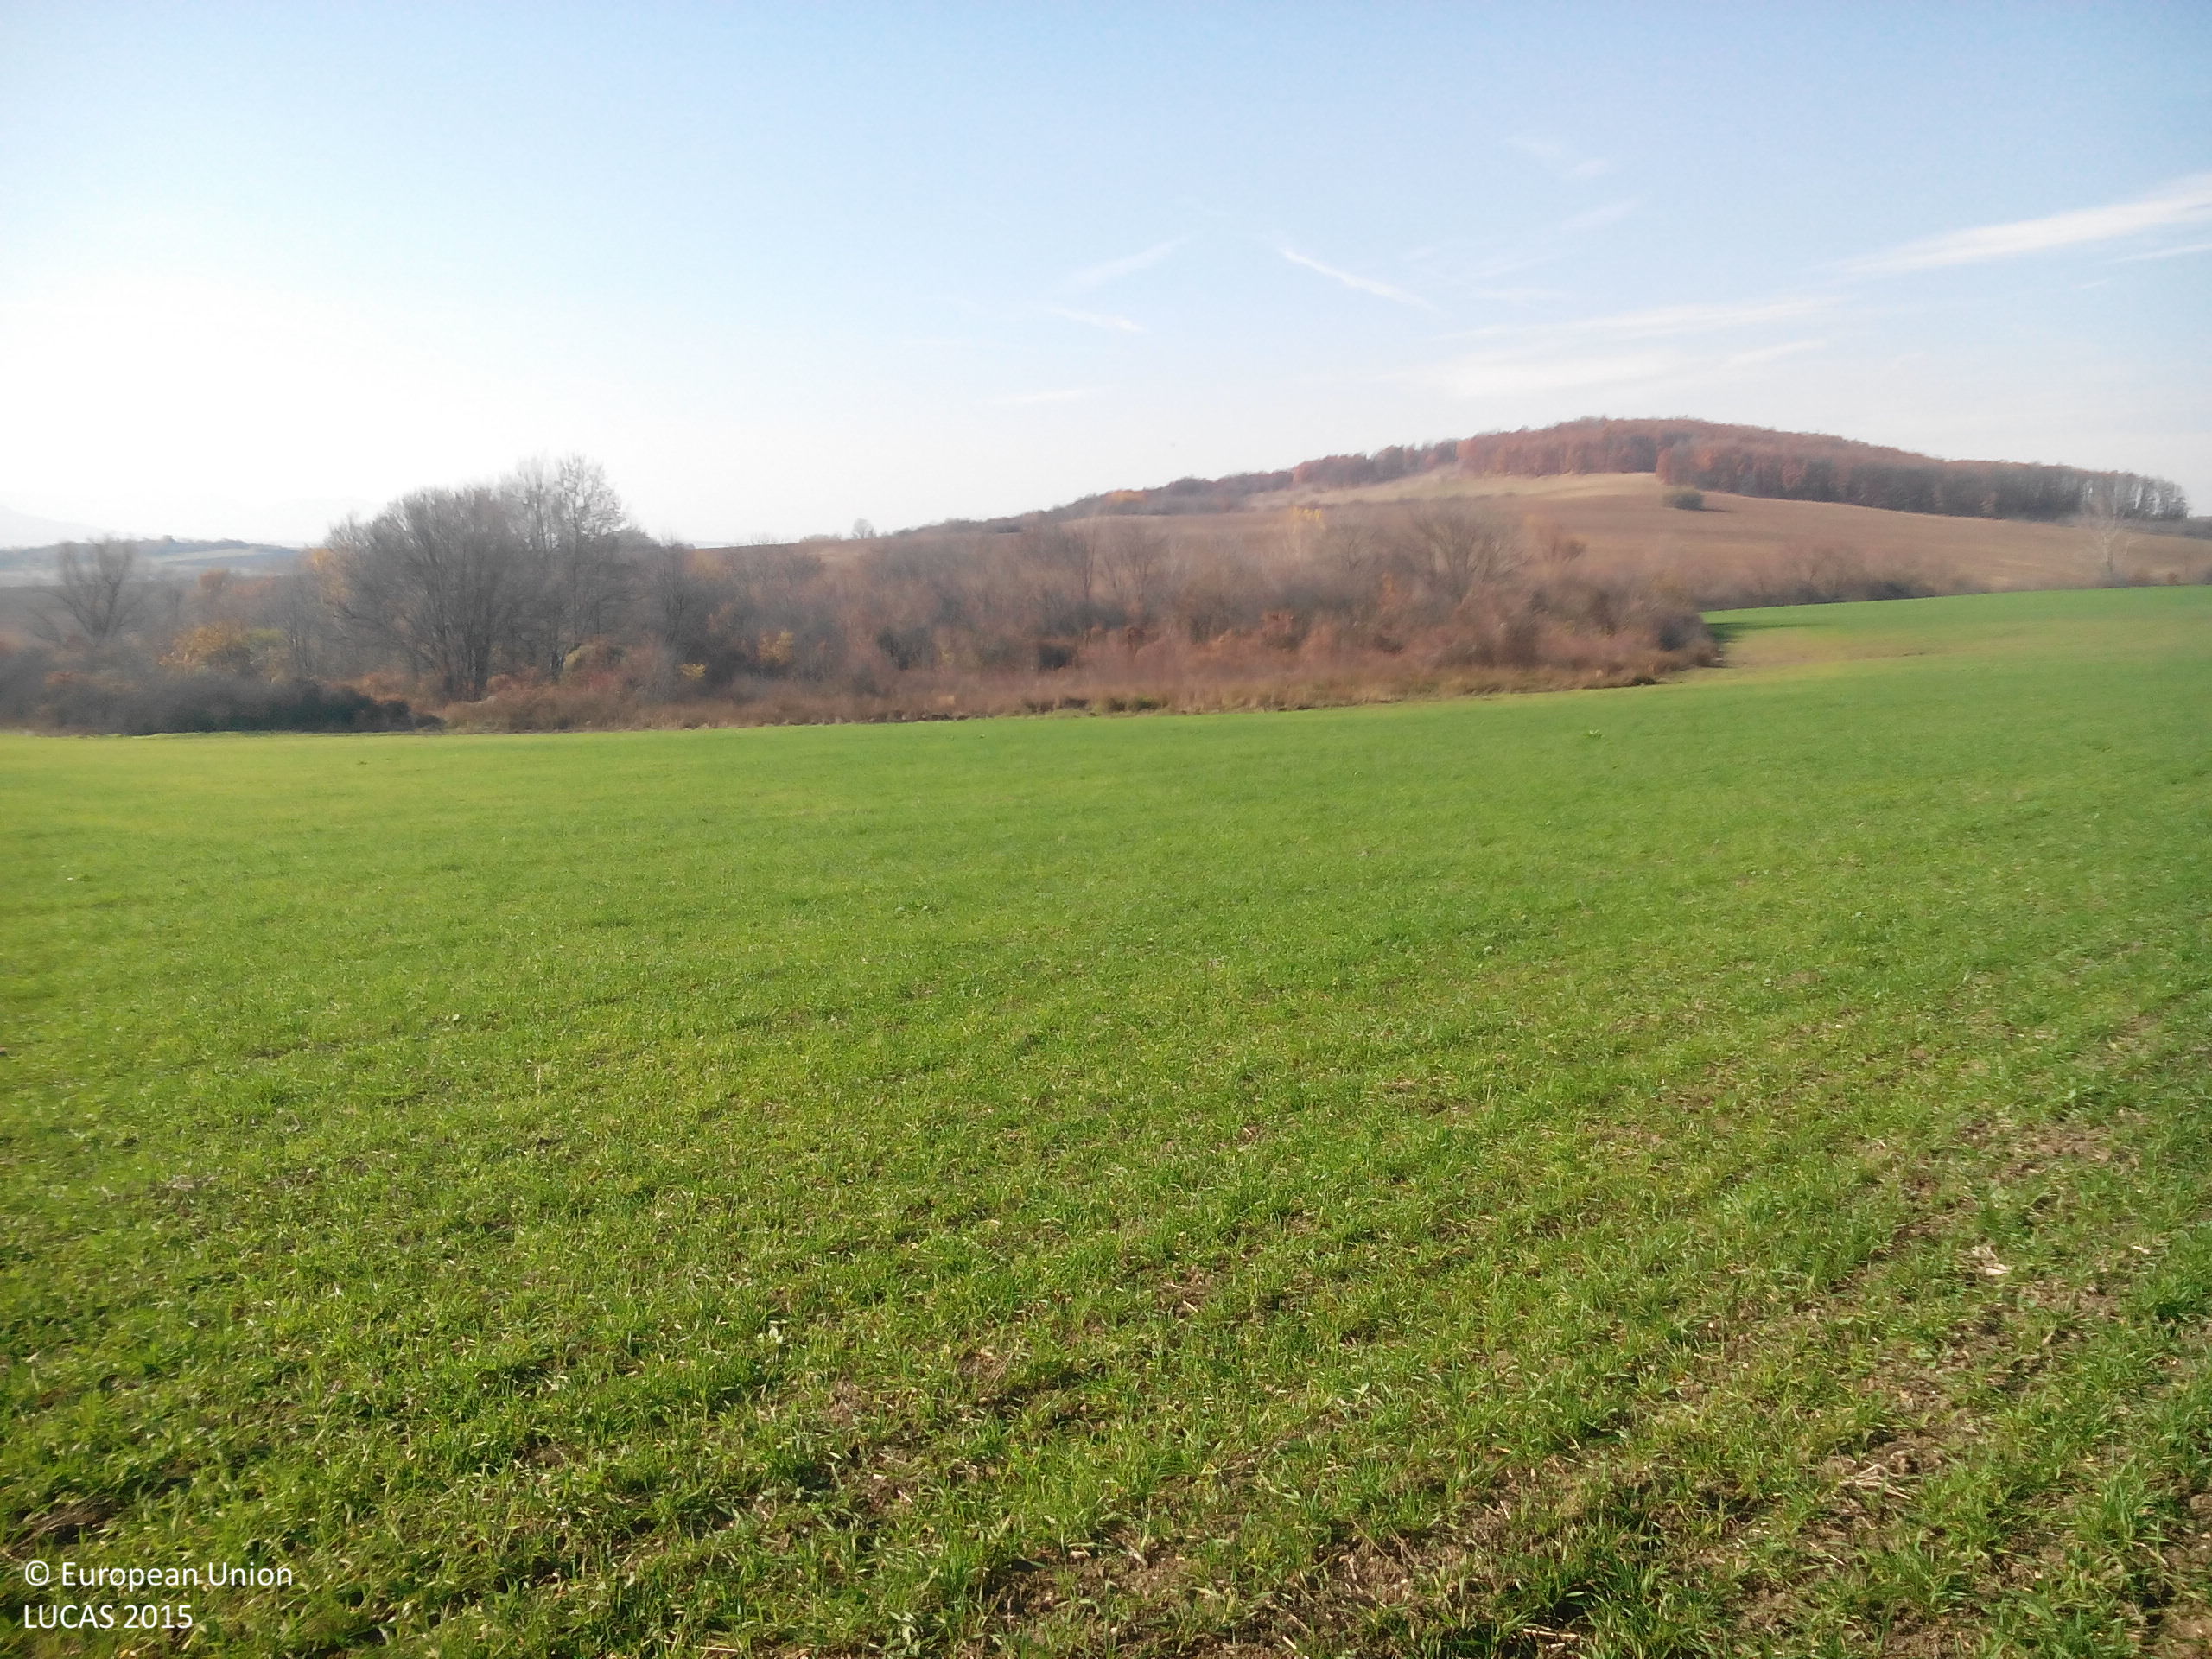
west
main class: Cropland
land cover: Common wheat
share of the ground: 50 - 75 %
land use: Agriculture (excluding fallow land and kitchen gardens)
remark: Harvested field
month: November
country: BG
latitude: 43.3111
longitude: 23.8195
